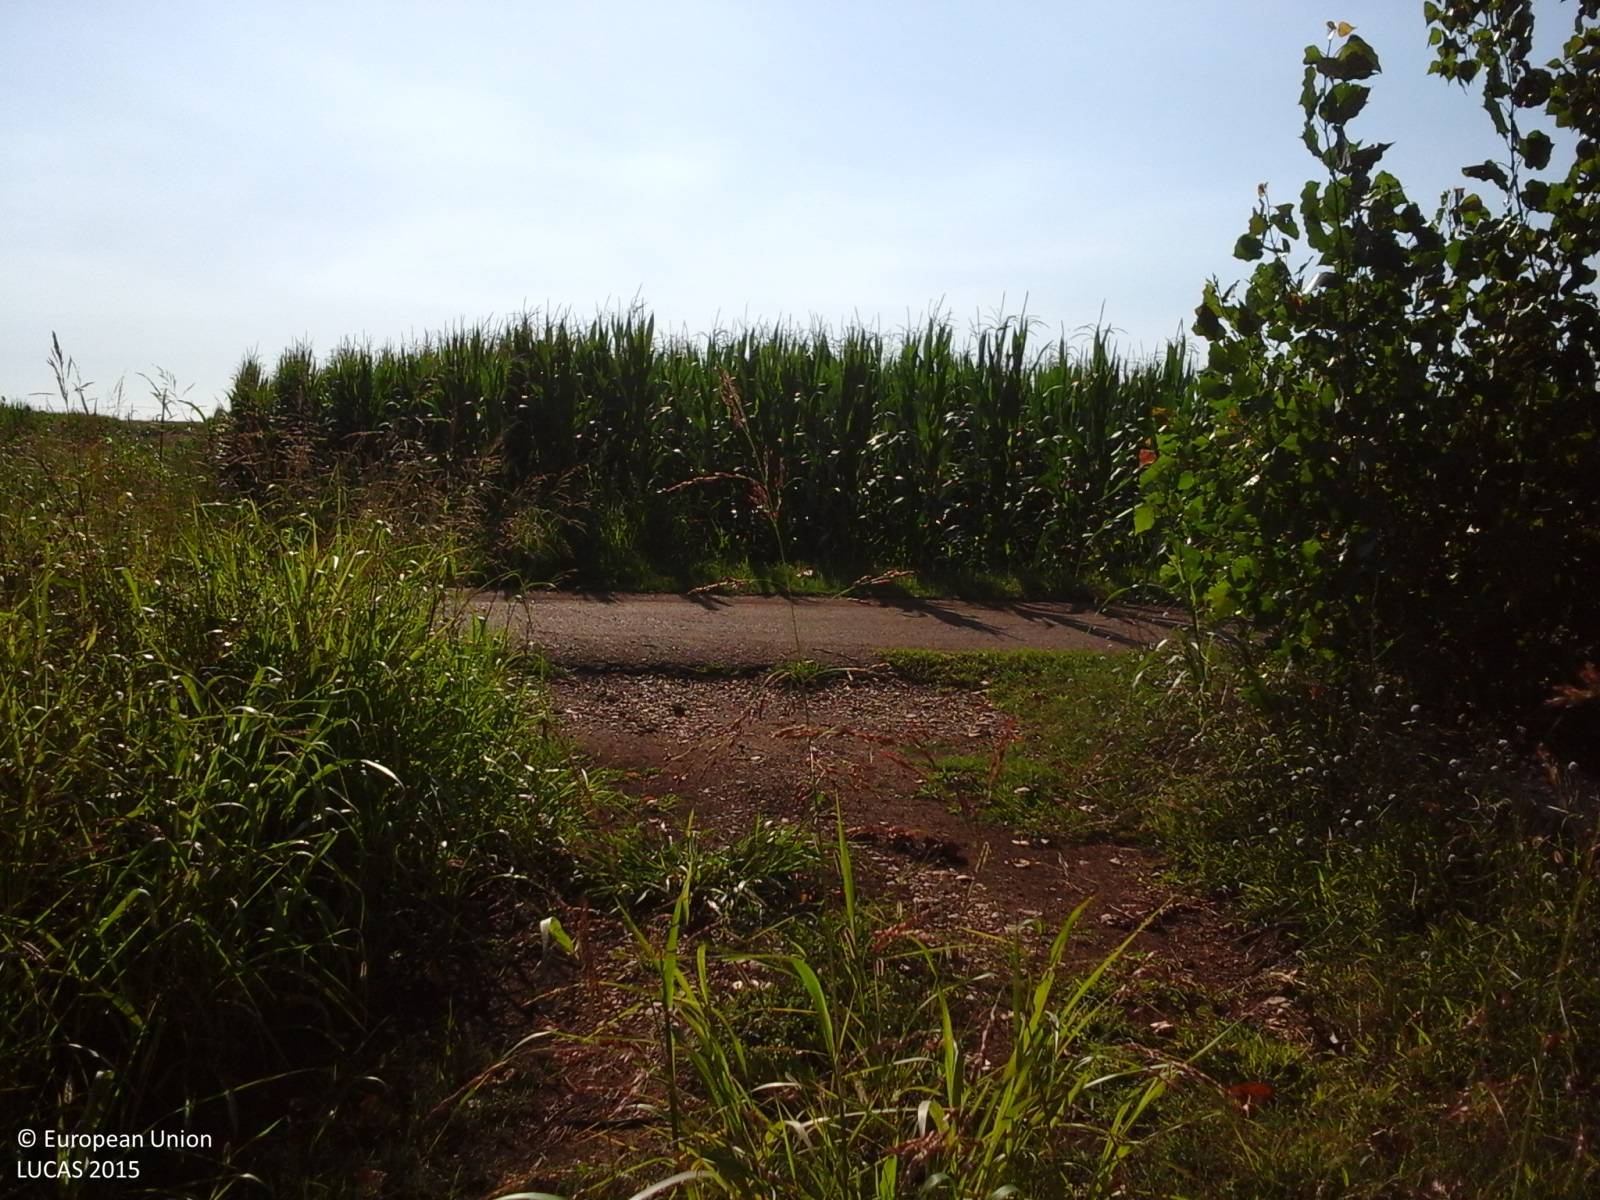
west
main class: Cropland
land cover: Maize
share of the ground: > 75 %
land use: Agriculture (excluding fallow land and kitchen gardens)
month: August
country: IT
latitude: 41.4113
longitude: 13.1576
